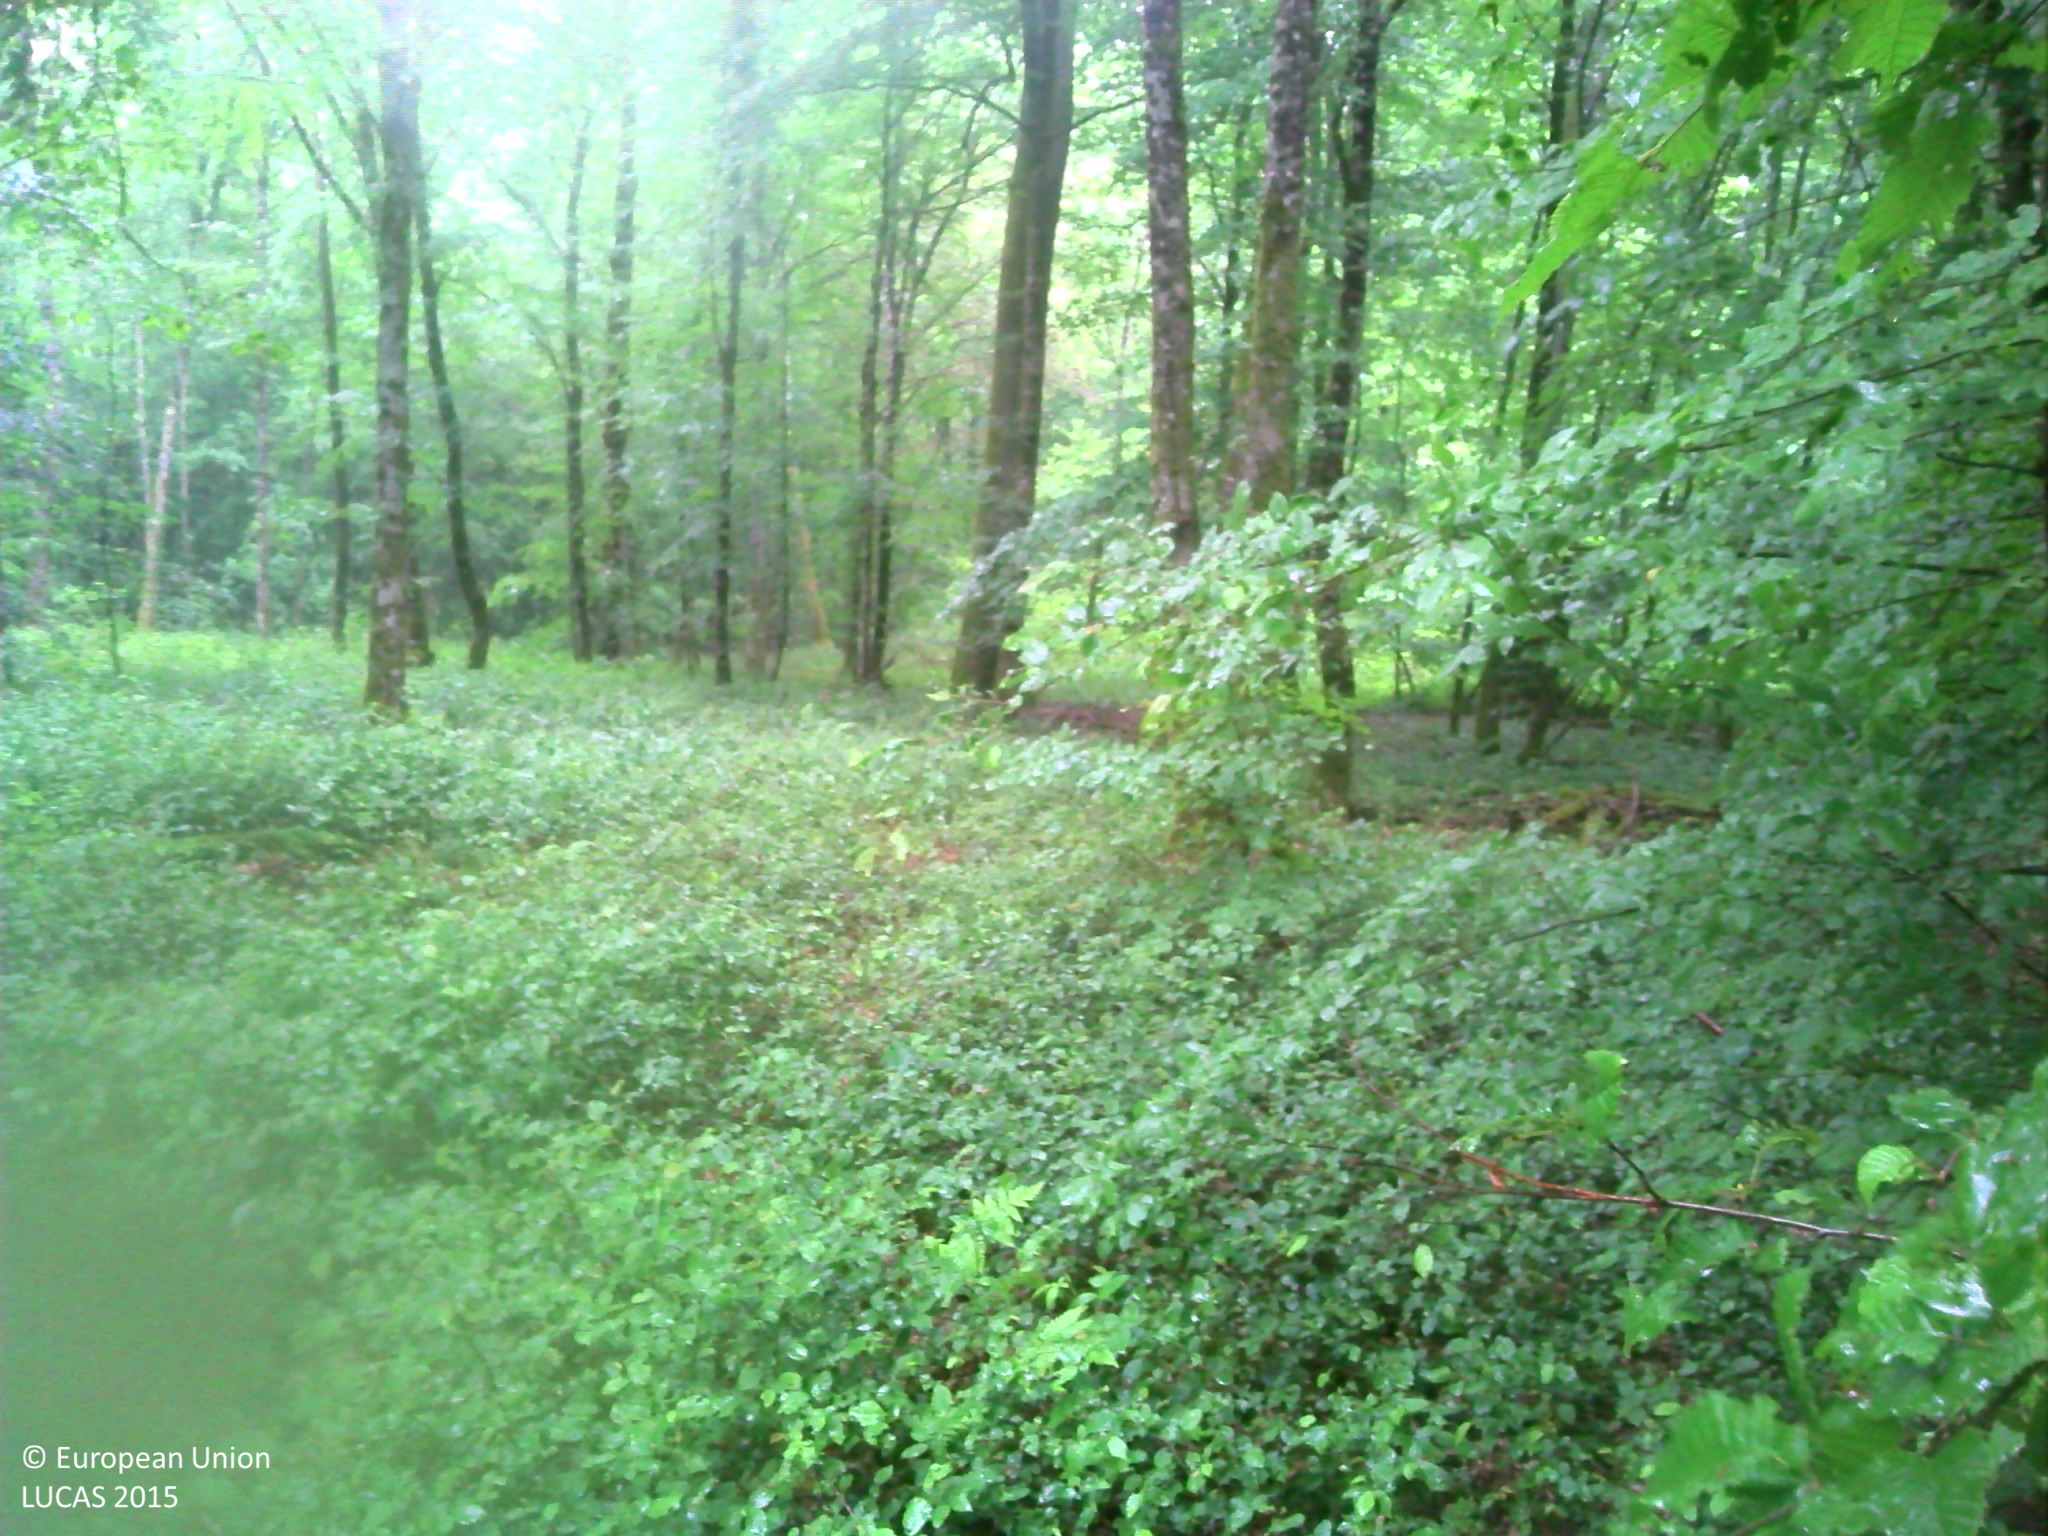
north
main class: Woodland
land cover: Broadleaved woodland
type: mesophytic deciduous forest
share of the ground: > 75 %
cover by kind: broadleaved forest trees 90 %, herbaceous plants 10 %
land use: Forestry
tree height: > 5 m
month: May
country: FR
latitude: 48.6121
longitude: 4.9389
